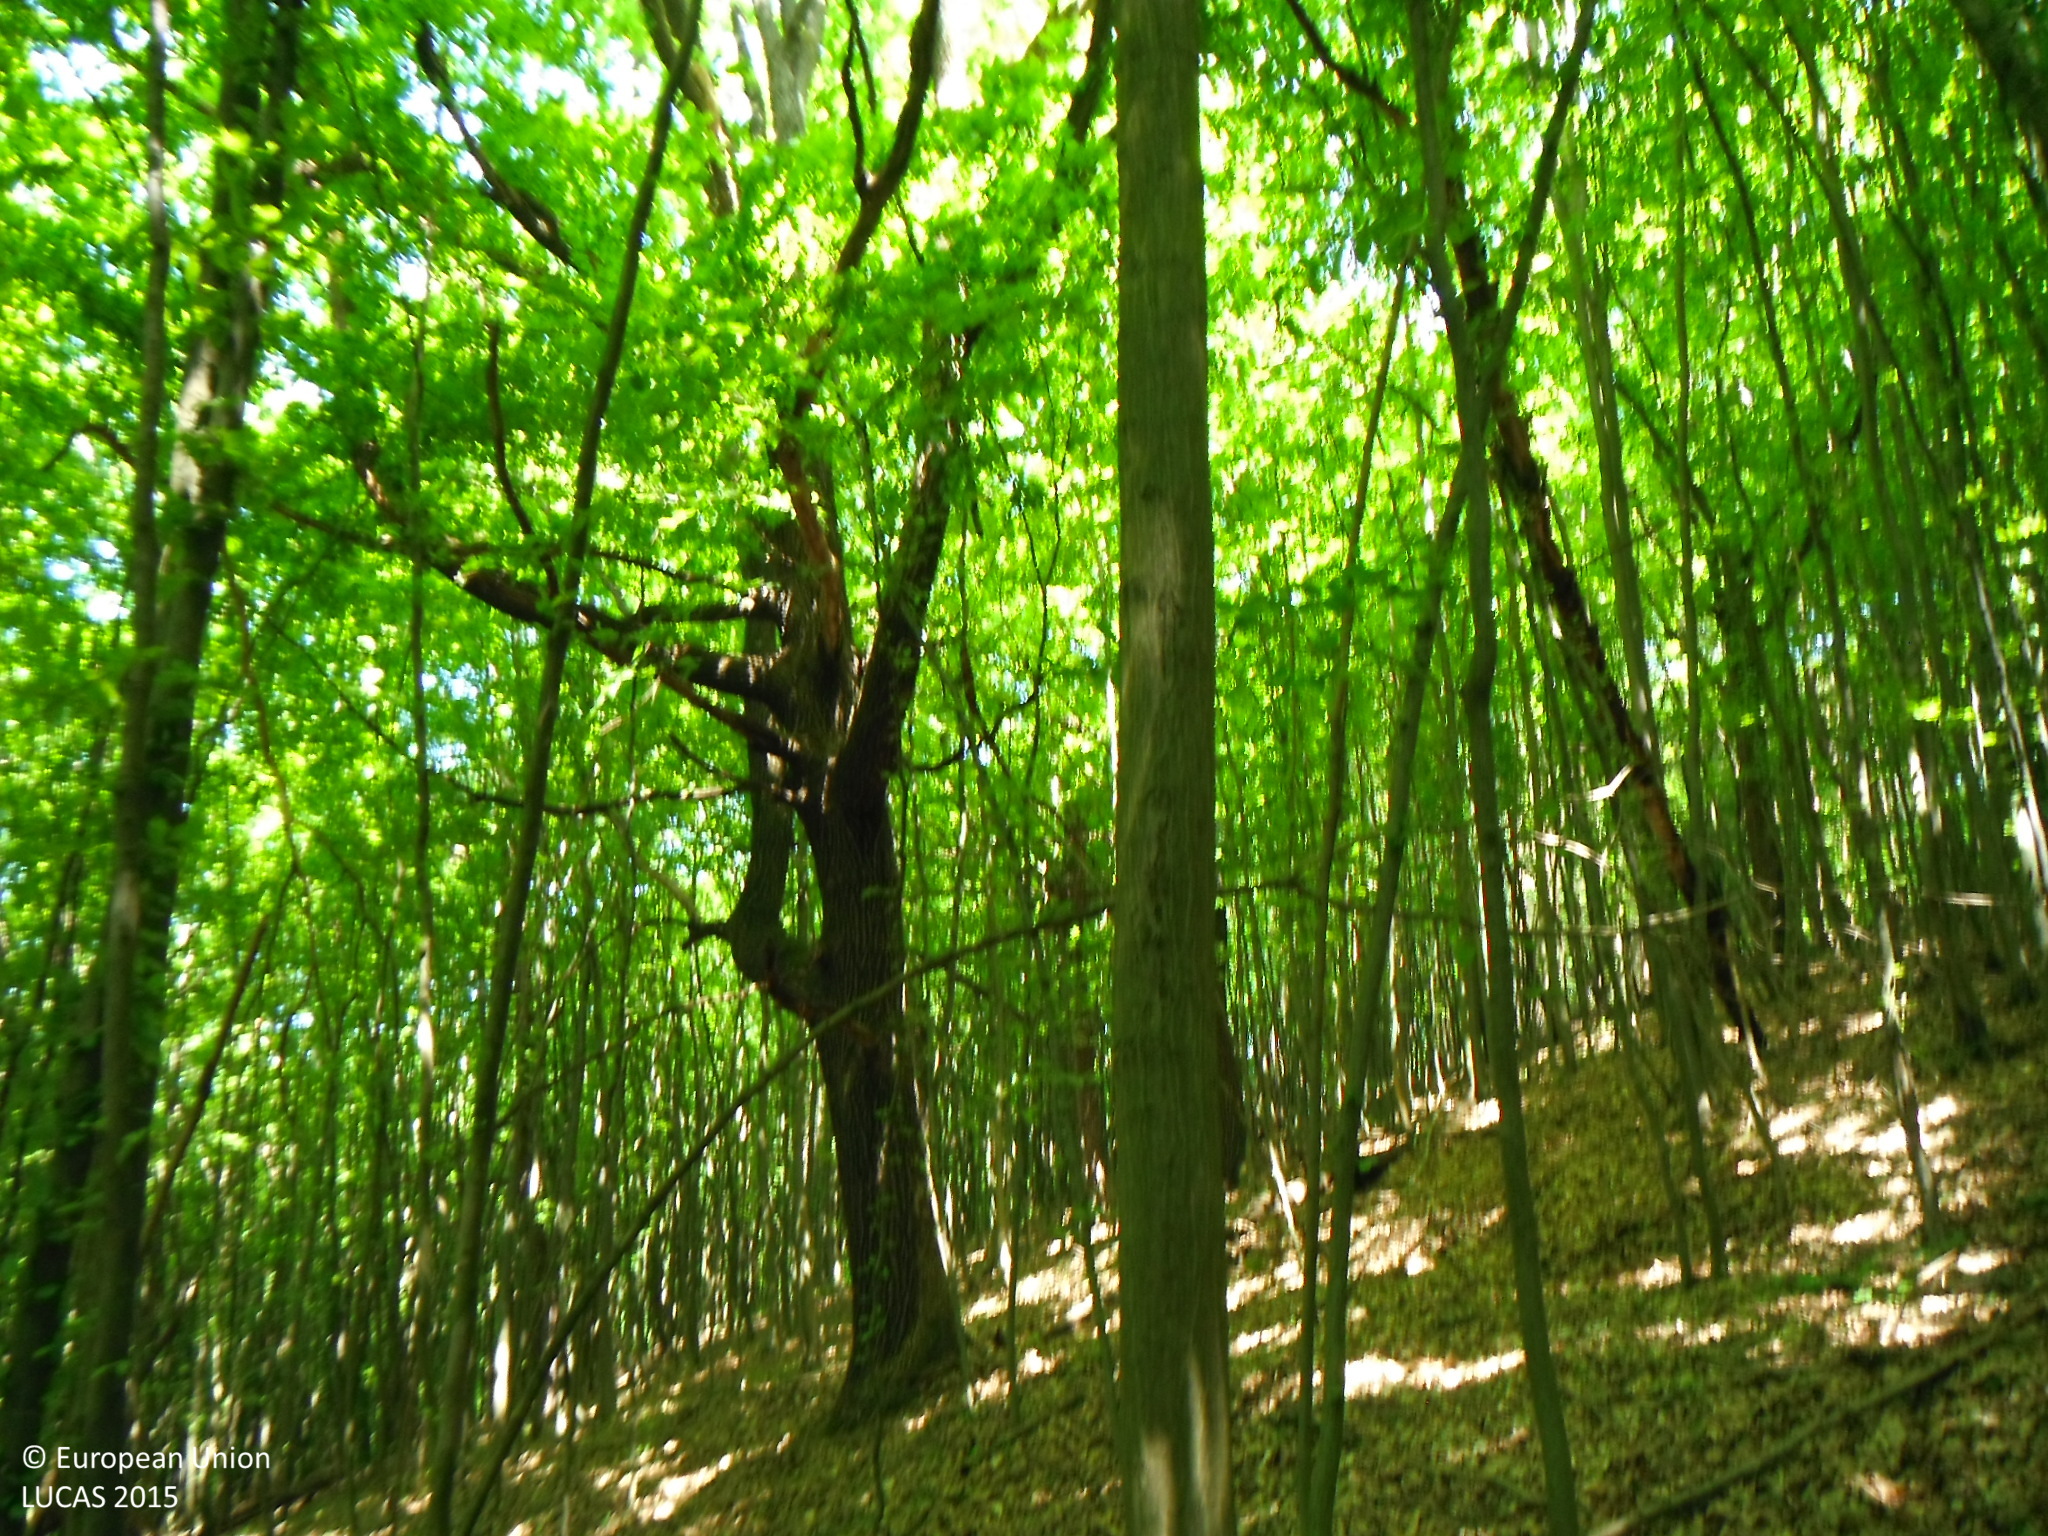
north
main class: Woodland
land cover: Broadleaved woodland
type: mesophytic deciduous forest
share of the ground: > 75 %
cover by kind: broadleaved forest trees 100 %
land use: Forestry
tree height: > 5 m
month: May
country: SK
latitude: 49.1145
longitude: 21.6272
